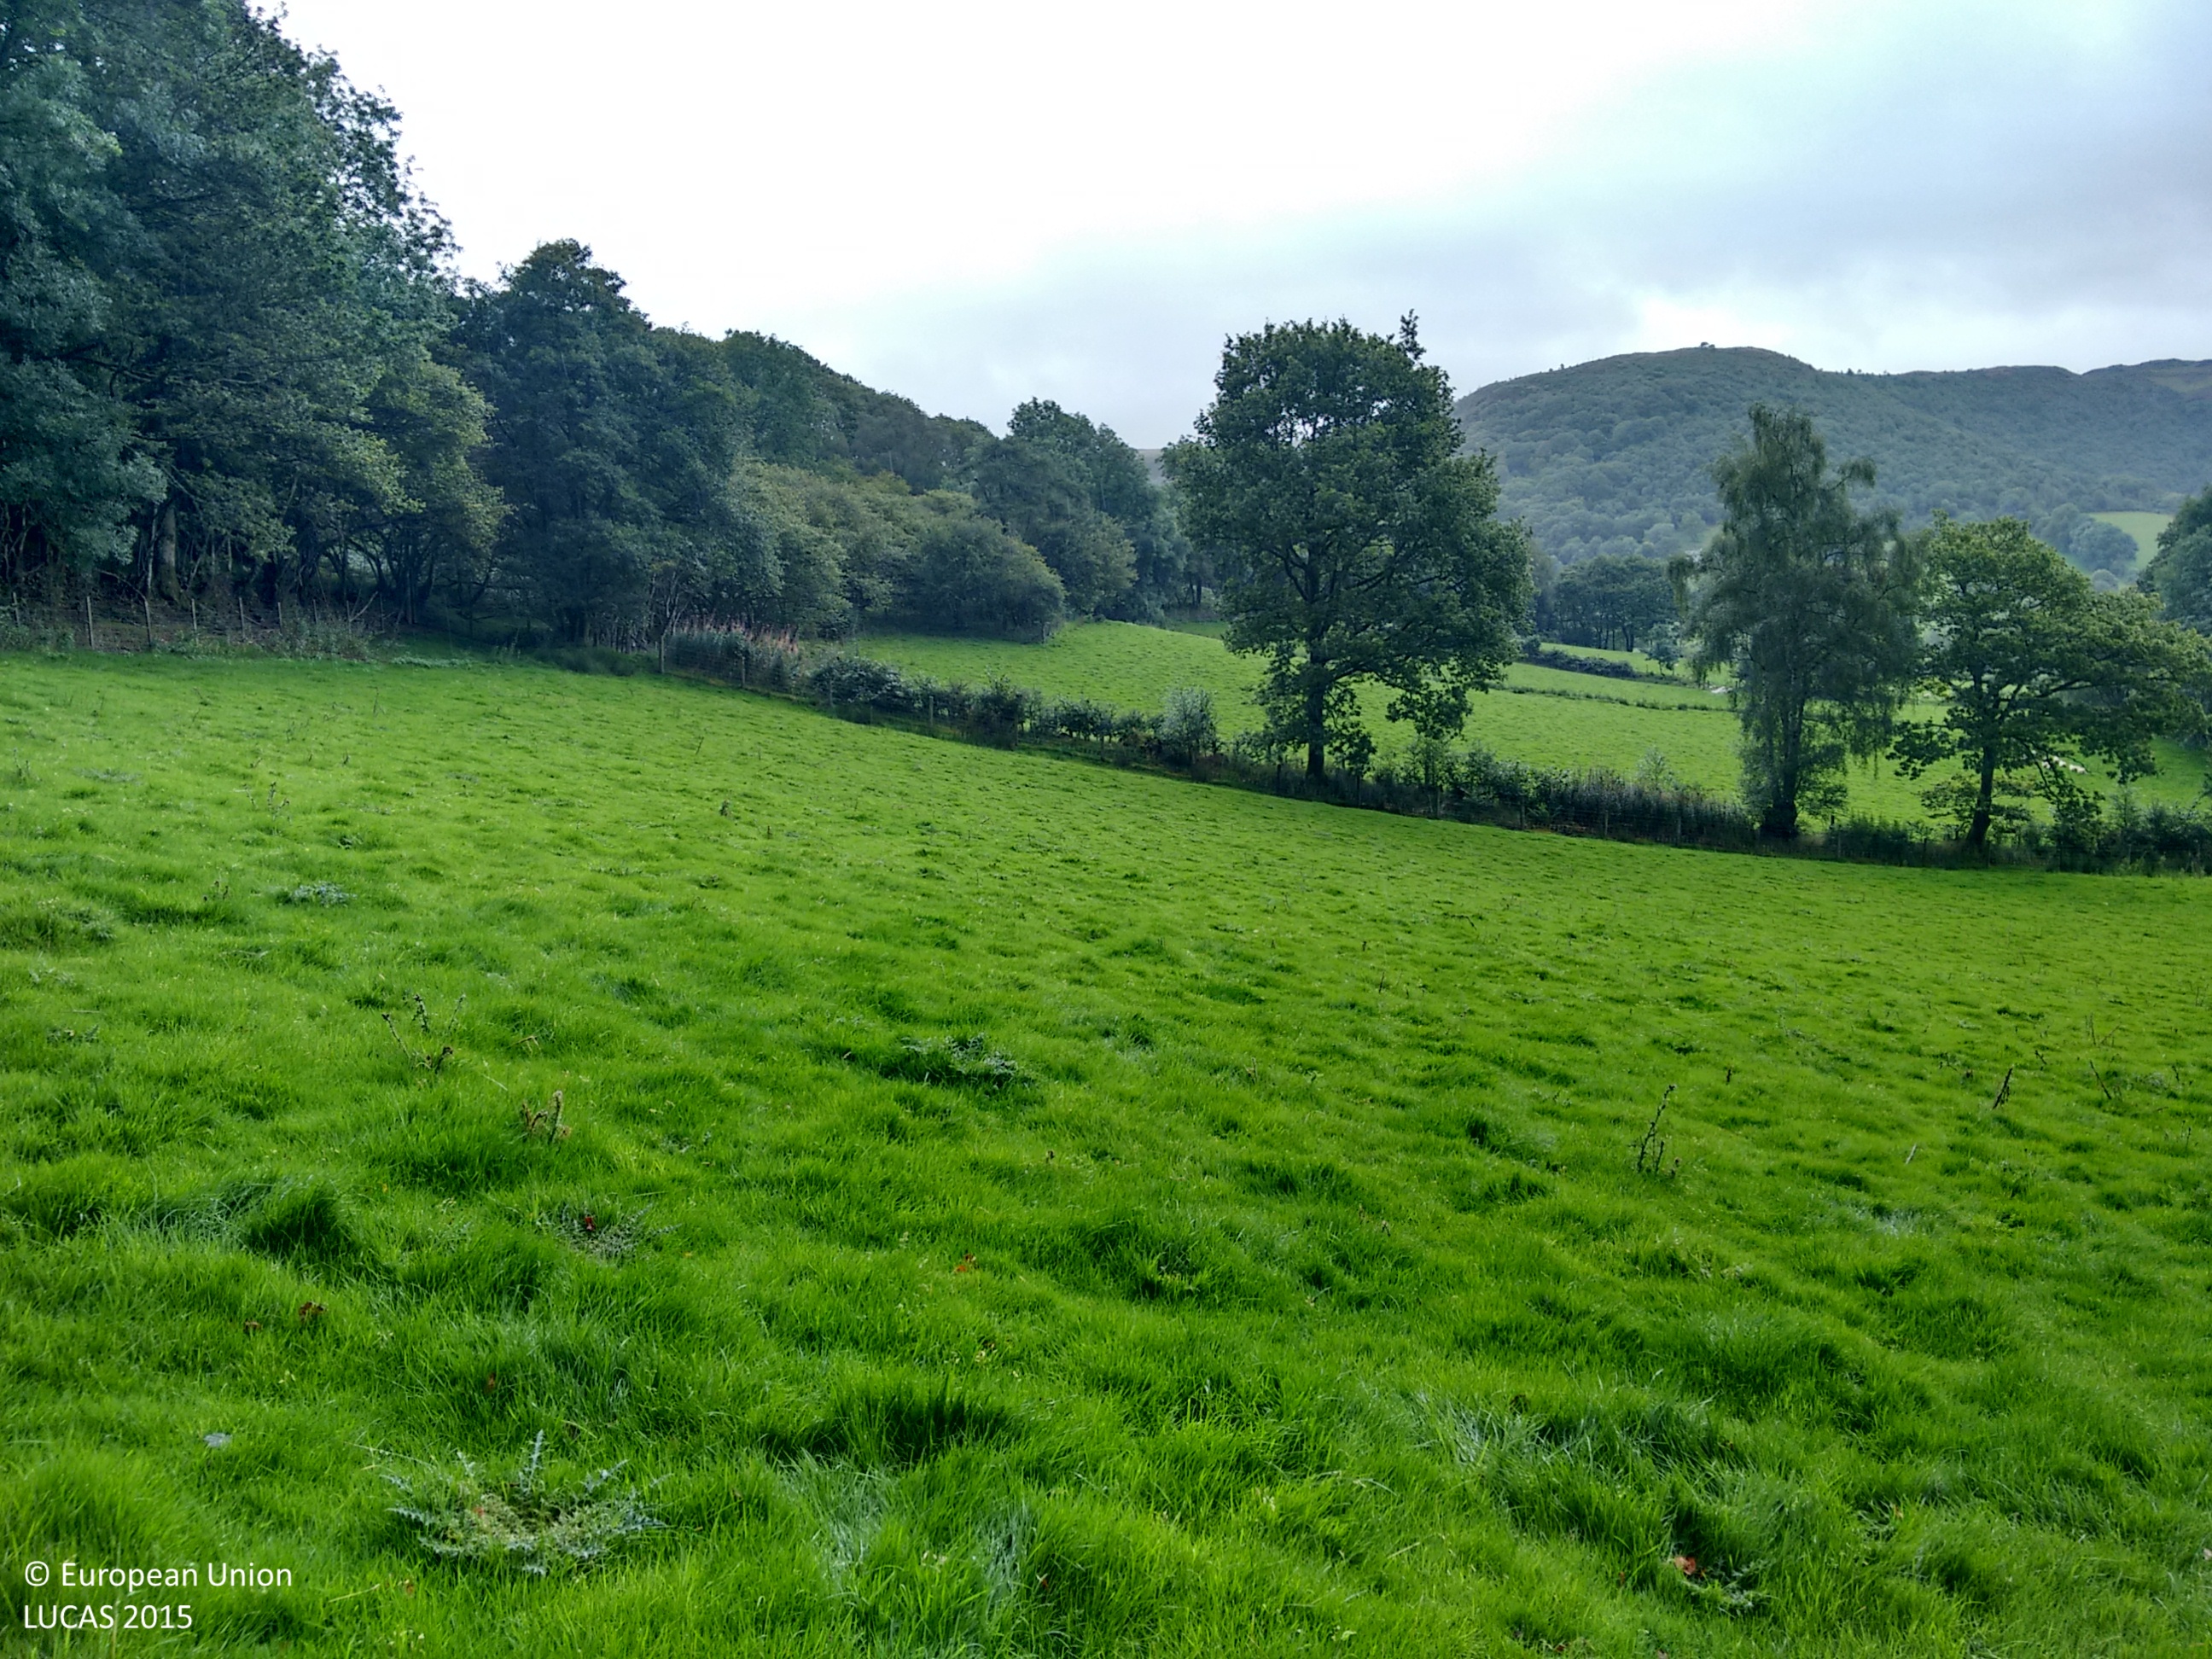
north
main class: Grassland
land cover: Grassland without tree/shrub cover
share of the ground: > 75 %
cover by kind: herbaceous plants 100 %
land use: Agriculture (excluding fallow land and kitchen gardens)
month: September
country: GB
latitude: 52.0926
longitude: -3.8258
